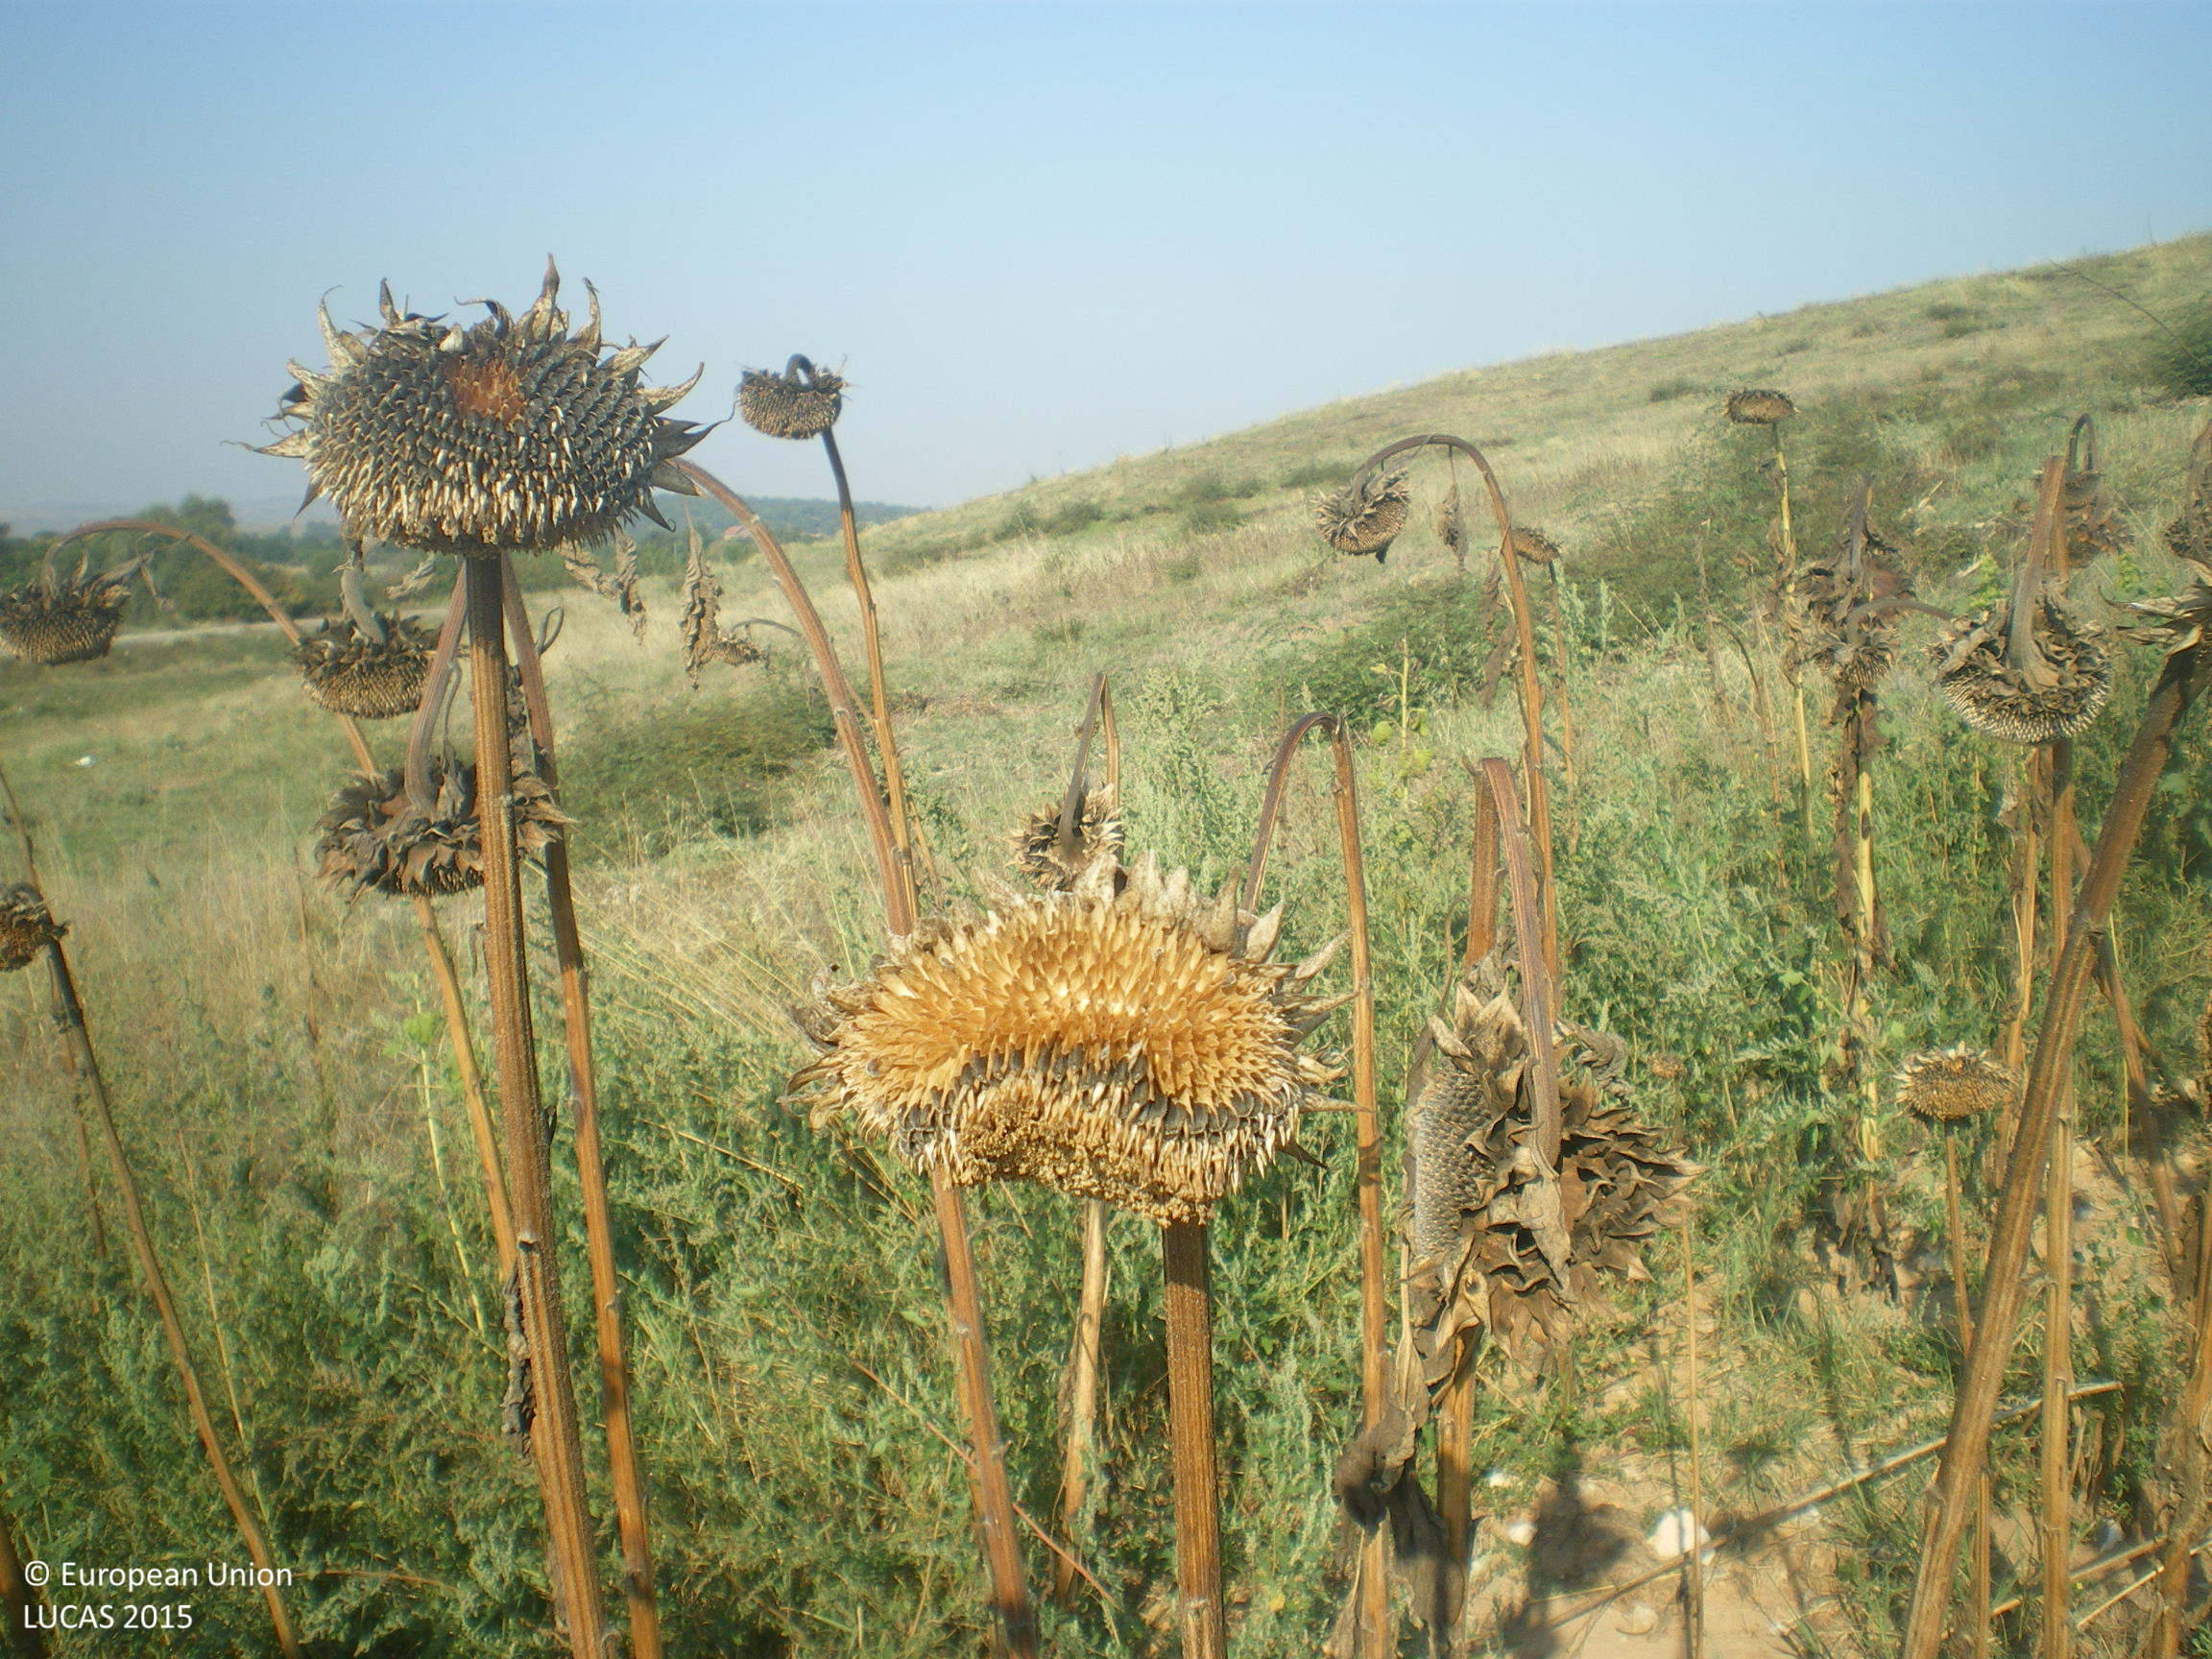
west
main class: Cropland
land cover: Sunflower
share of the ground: > 75 %
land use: Agriculture (excluding fallow land and kitchen gardens)
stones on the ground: > 50 %
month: August
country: BG
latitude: 42.0266
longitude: 25.9315
